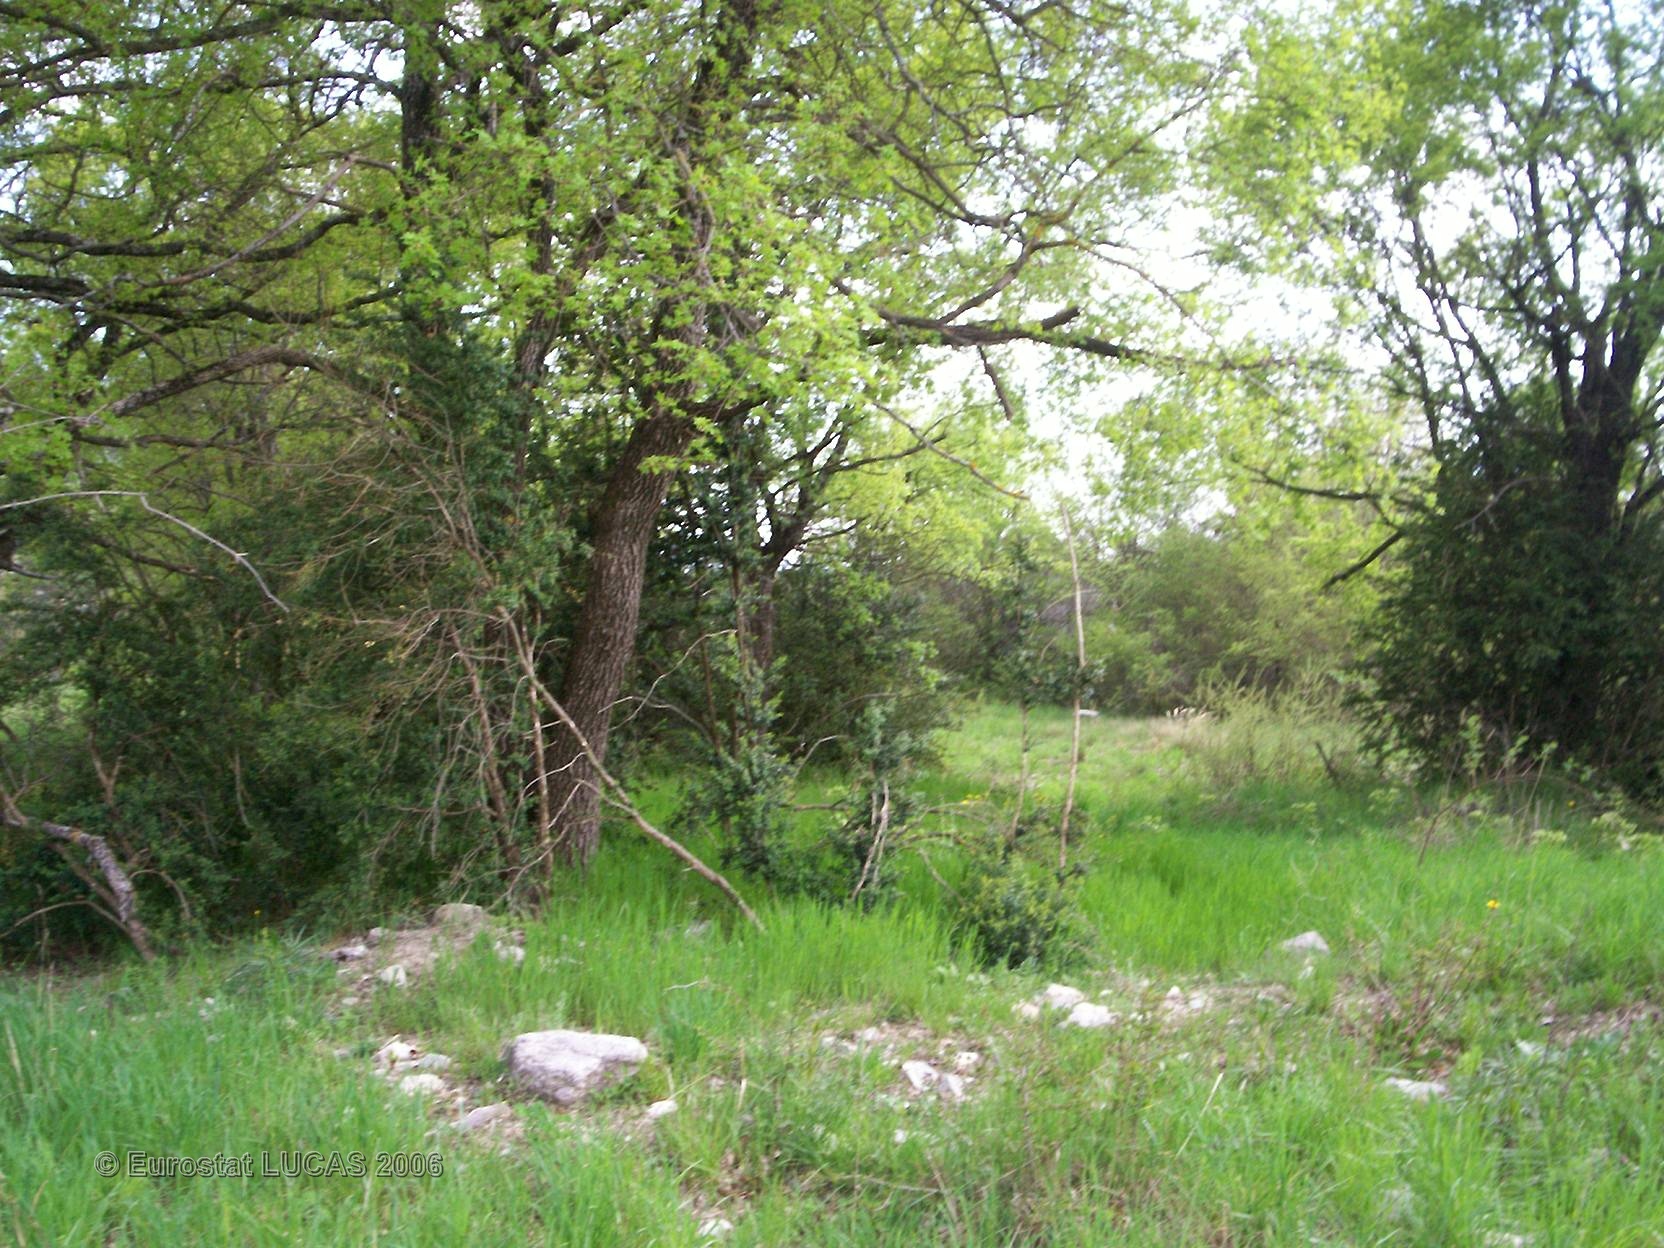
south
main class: Cropland
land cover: Lucerne
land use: Agriculture (excluding fallow land and kitchen gardens)
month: May
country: FR
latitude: 43.8766
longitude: 6.5106
